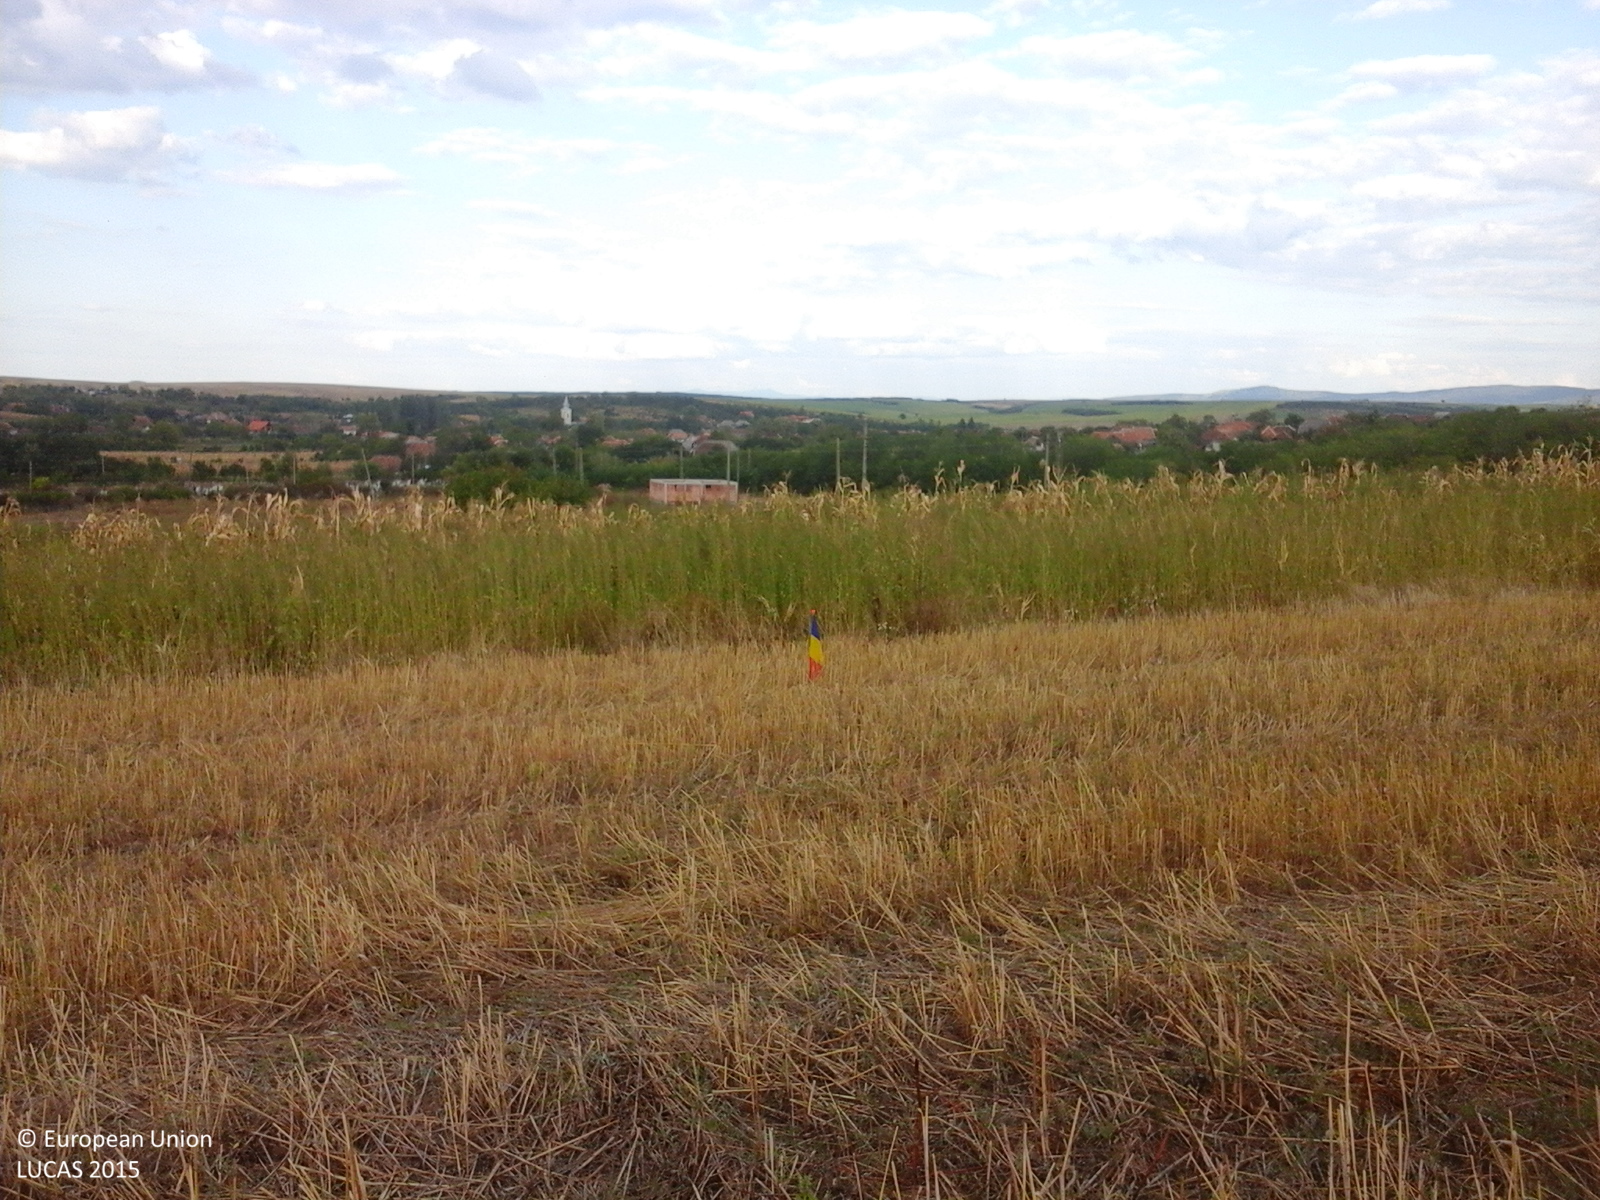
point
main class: Cropland
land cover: Oats
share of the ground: 50 - 75 %
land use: Agriculture (excluding fallow land and kitchen gardens)
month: September
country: RO
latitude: 47.6043
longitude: 22.9270
